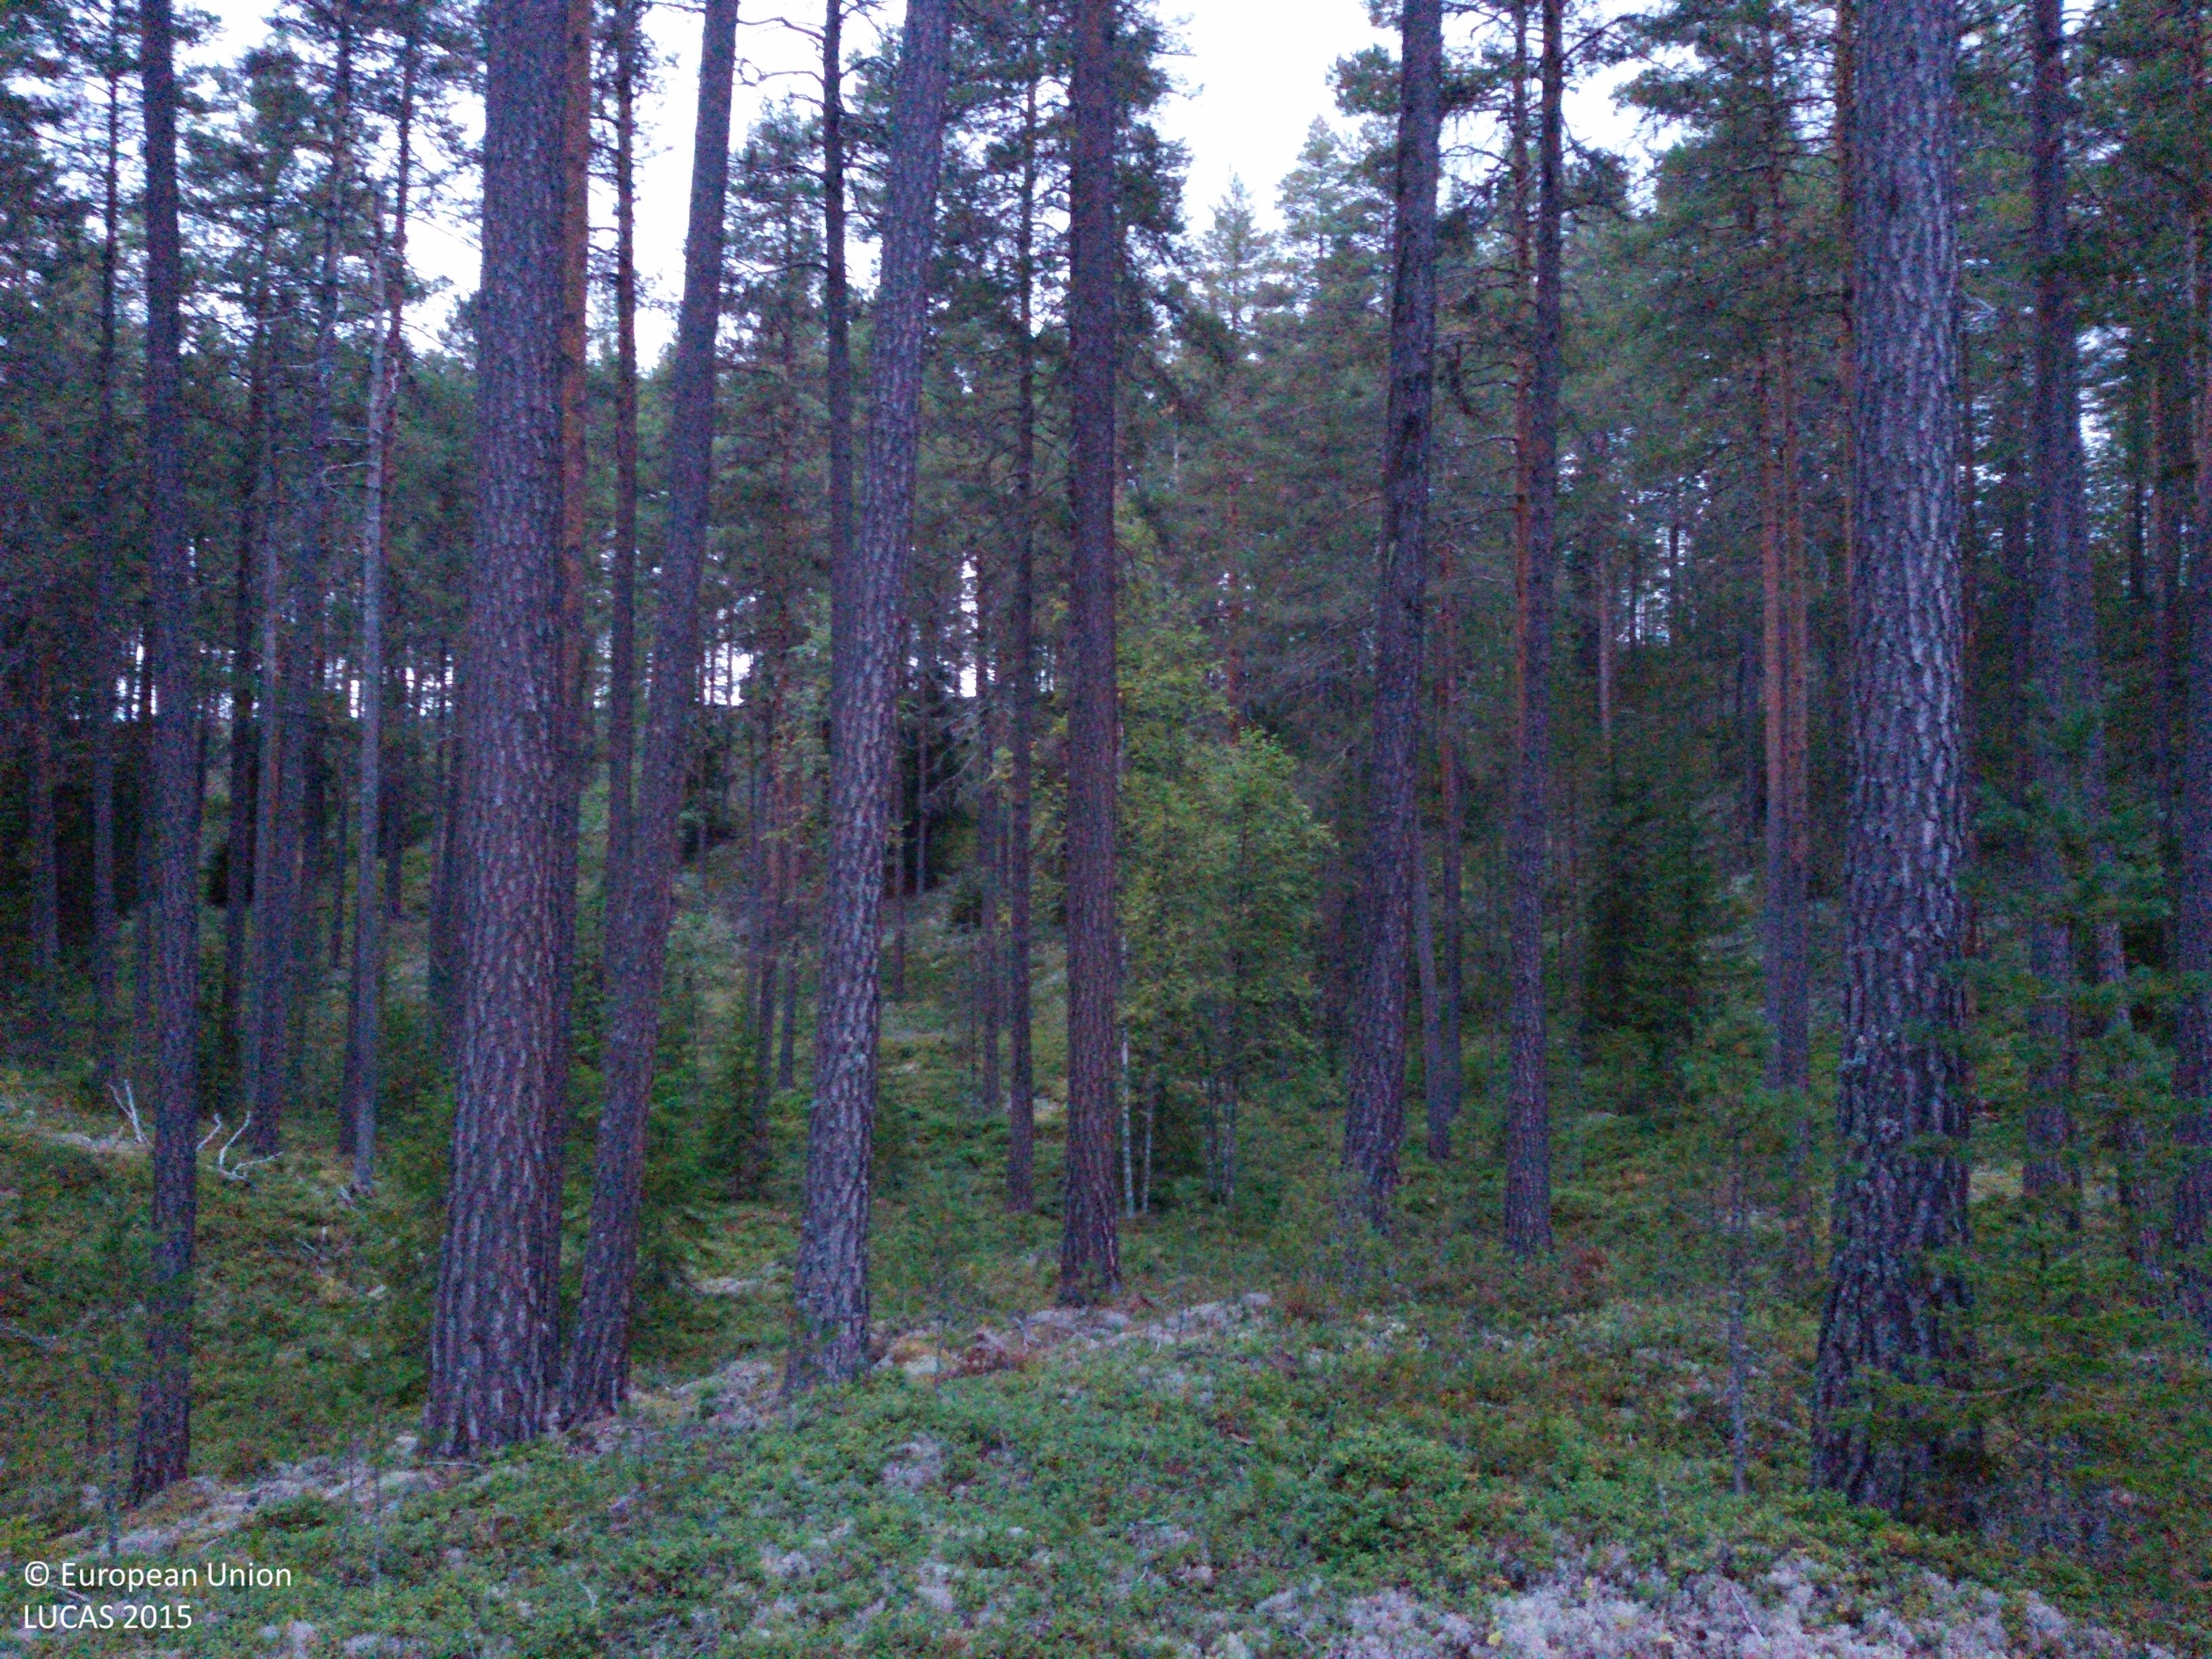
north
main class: Woodland
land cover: Pine dominated coniferous woodland
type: boreal forest
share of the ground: 50 - 75 %
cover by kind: coniferous forest trees 65 %, lichens and mosses 25 %, shrubs 10 %
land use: Forestry
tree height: > 5 m
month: August
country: SE
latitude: 60.9895
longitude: 16.0675
